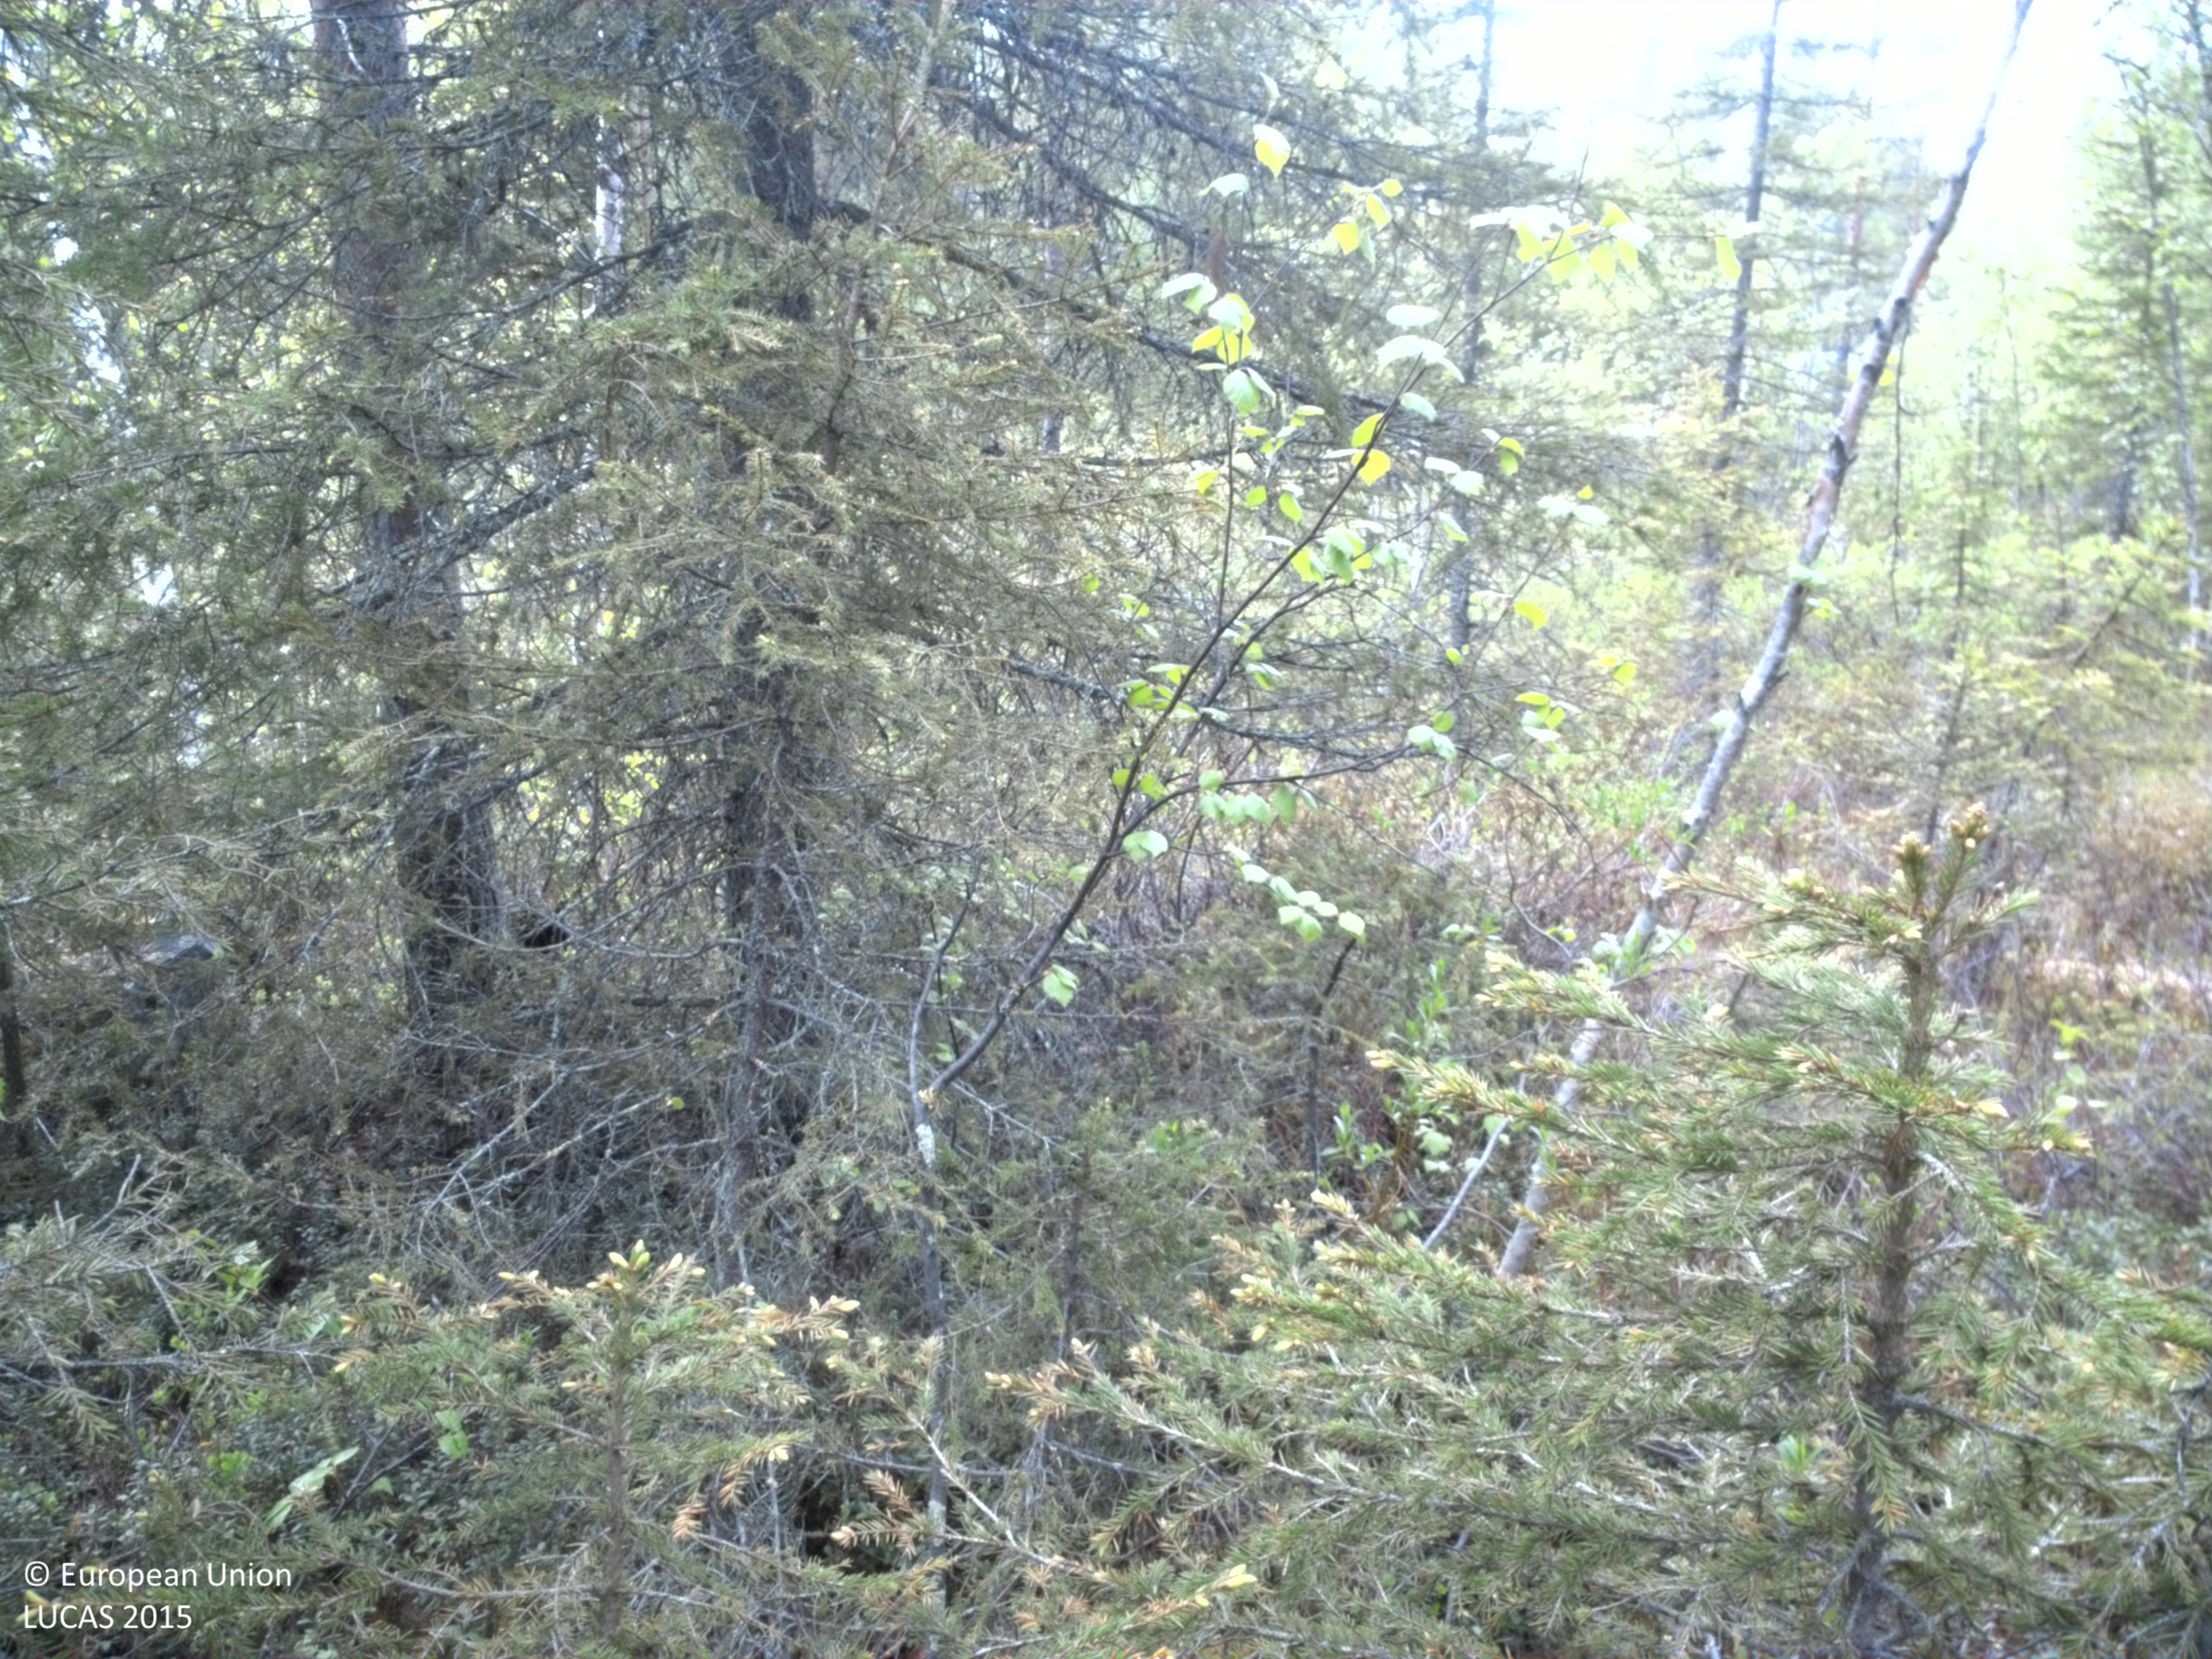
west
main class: Woodland
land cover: Other mixed woodland
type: boreal forest
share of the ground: 50 - 75 %
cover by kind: coniferous forest trees 35 %, shrubs 30 %, broadleaved forest trees 15 %, herbaceous plants 15 %, lichens and mosses 5 %
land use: Forestry
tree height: > 5 m
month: June
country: SE
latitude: 66.7515
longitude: 21.9274
